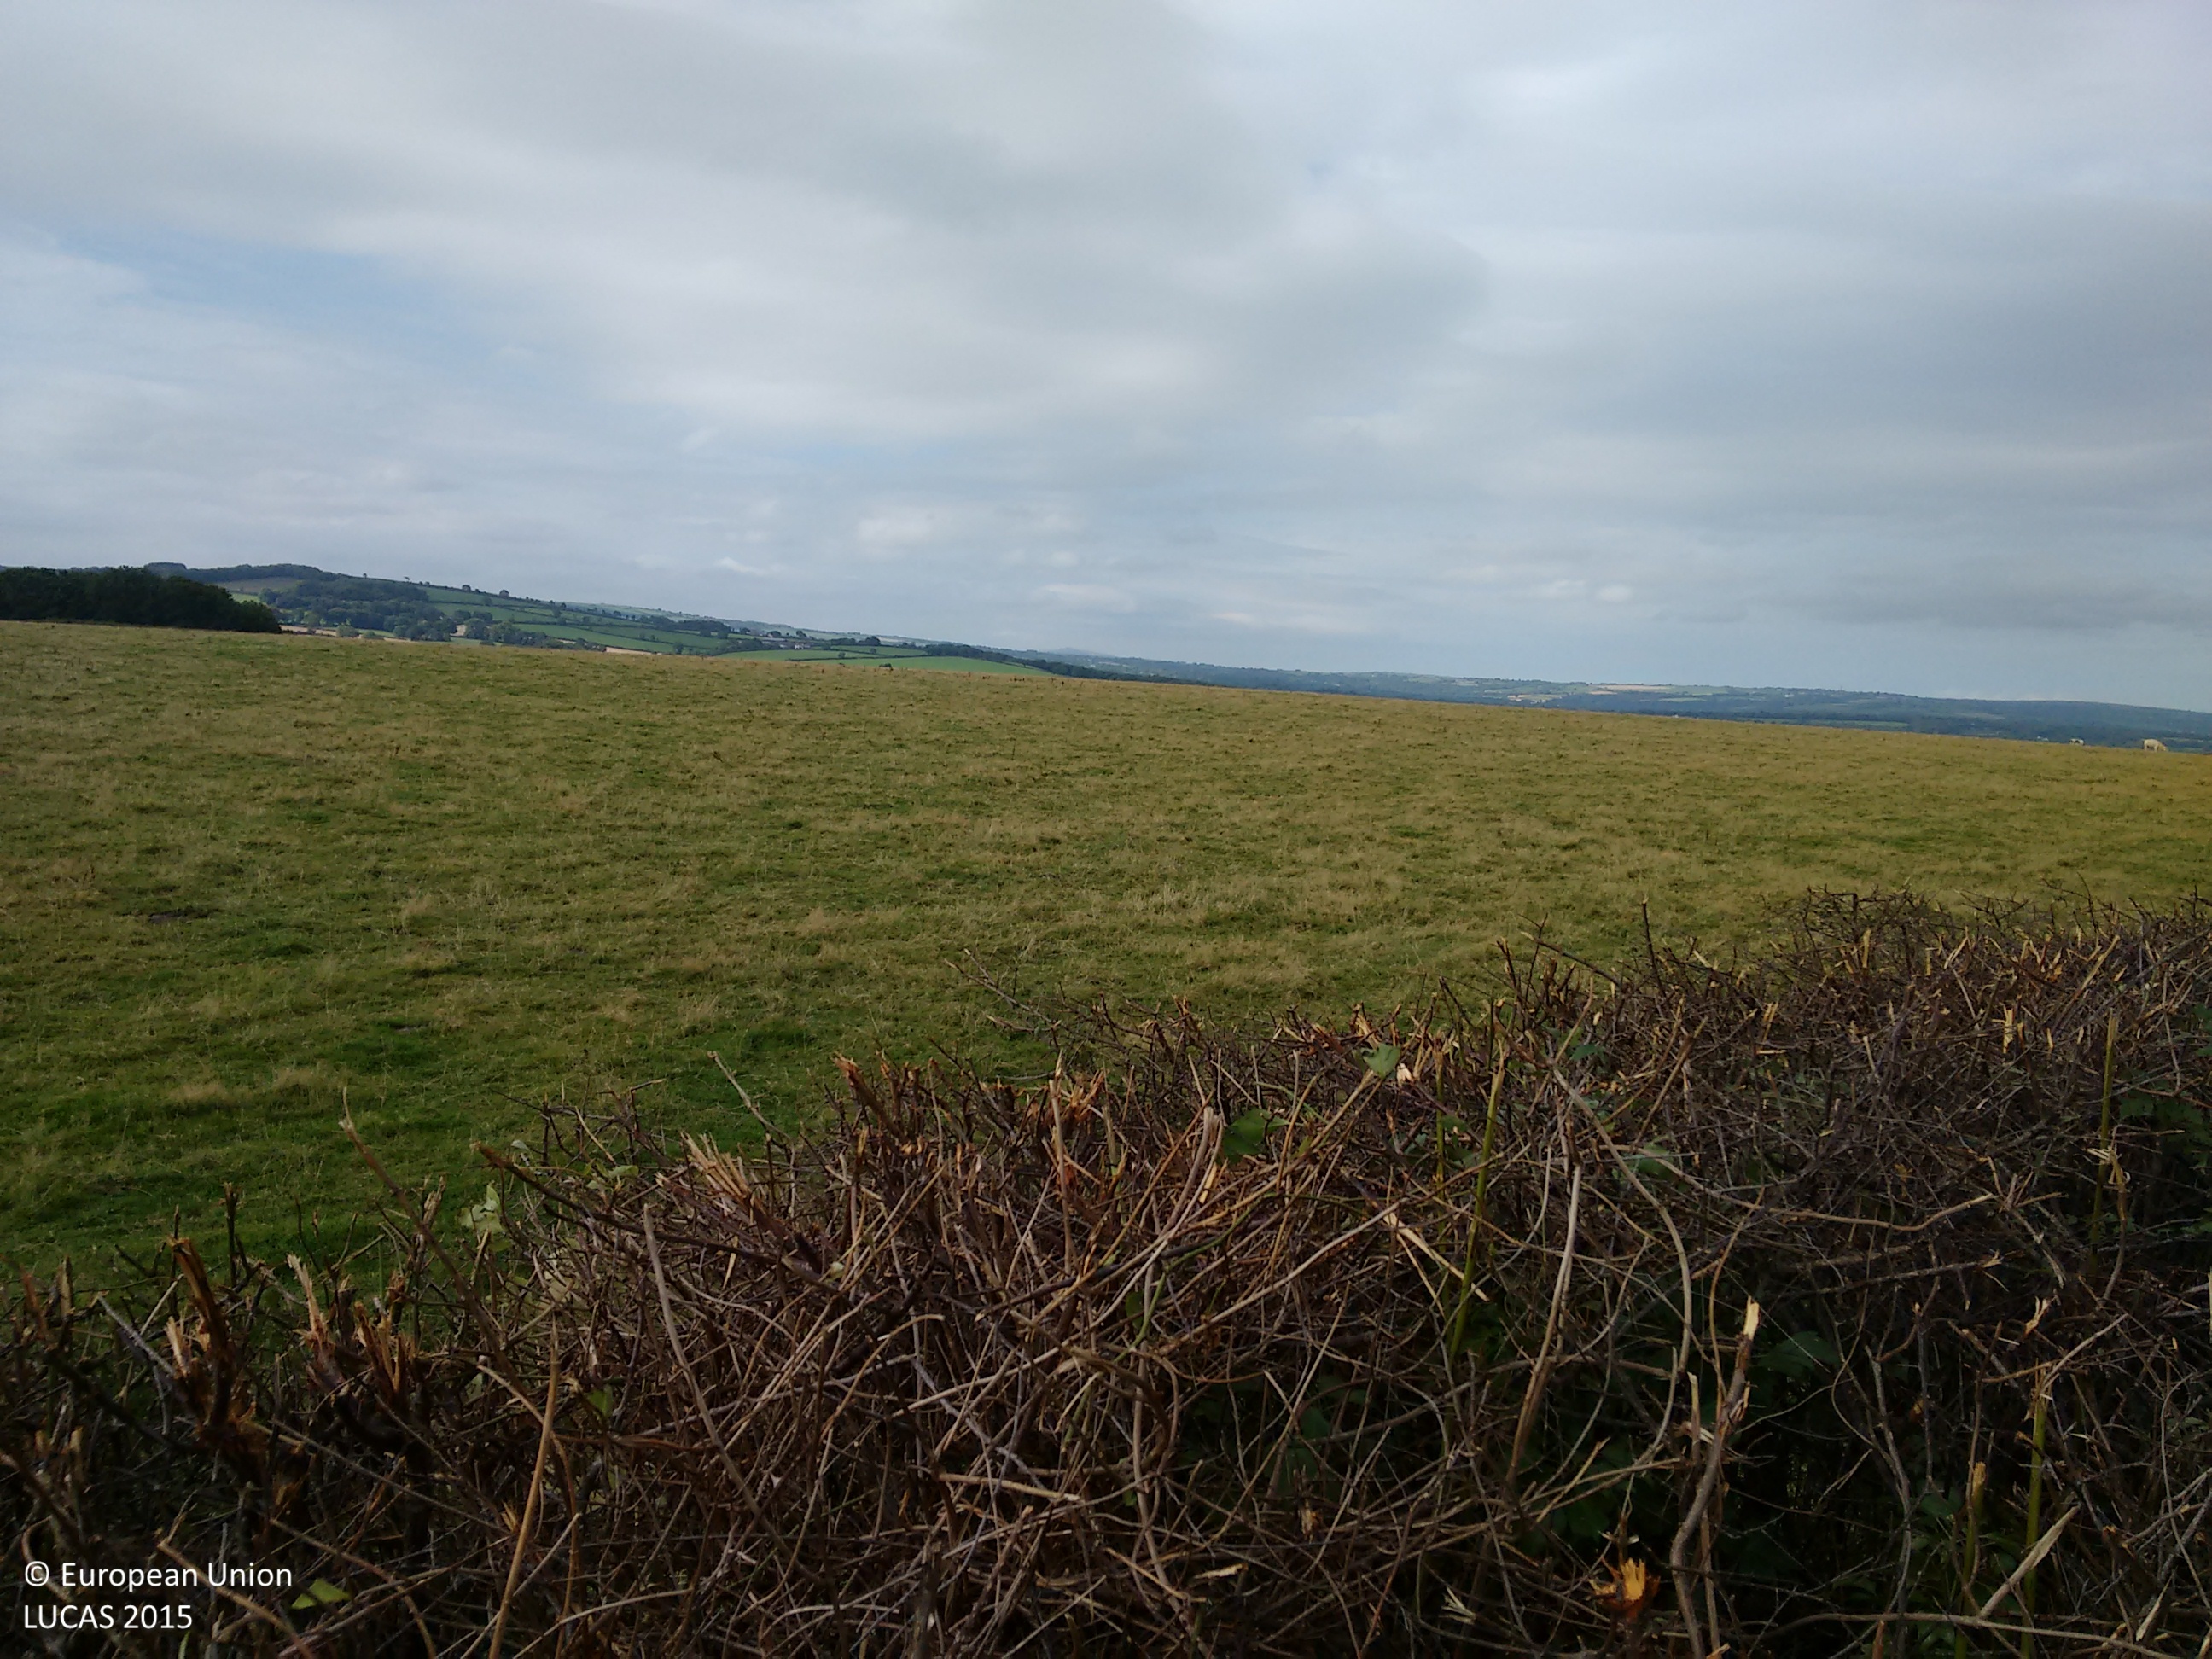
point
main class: Grassland
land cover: Grassland without tree/shrub cover
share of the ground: > 75 %
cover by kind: herbaceous plants 100 %
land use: Agriculture (excluding fallow land and kitchen gardens)
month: September
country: GB
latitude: 52.0582
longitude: -4.5604
